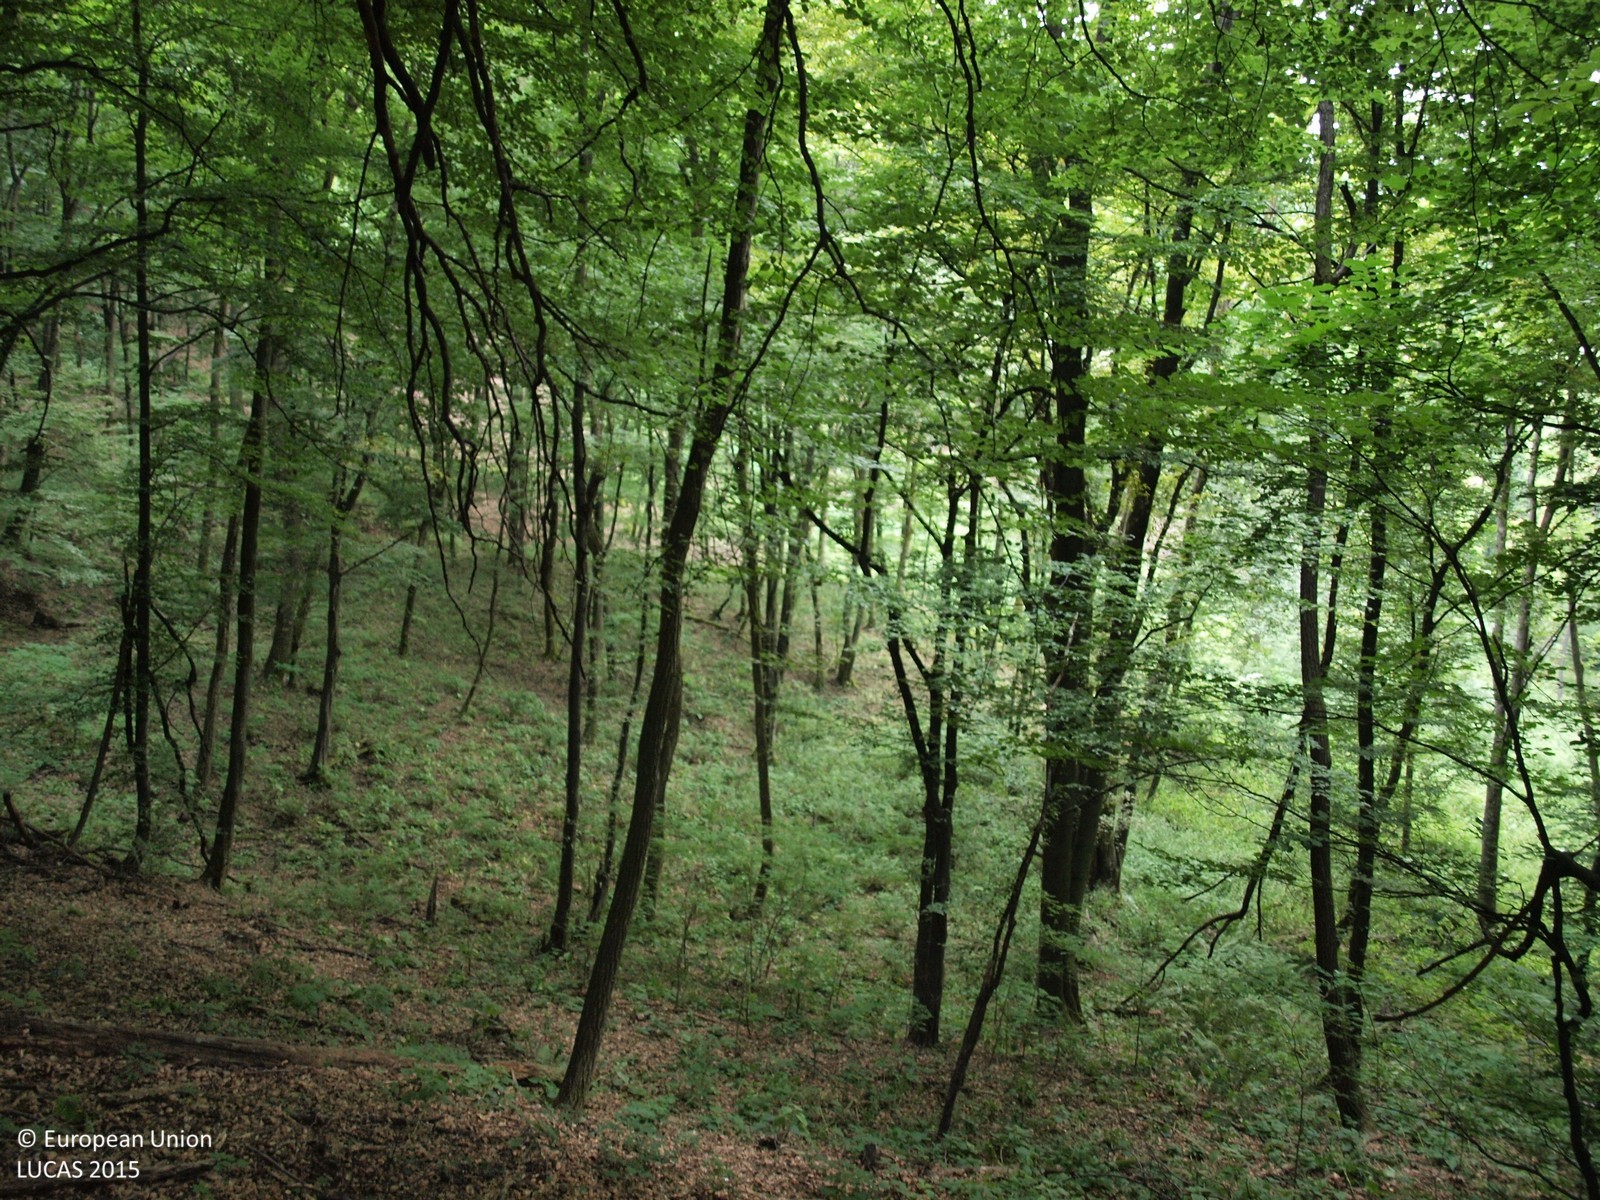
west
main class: Woodland
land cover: Broadleaved woodland
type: beech forest
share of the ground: > 75 %
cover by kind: broadleaved forest trees 90 %, shrubs 5 %, herbaceous plants 5 %
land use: Forestry
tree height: > 5 m
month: July
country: HR
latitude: 46.2033
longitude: 16.5712
